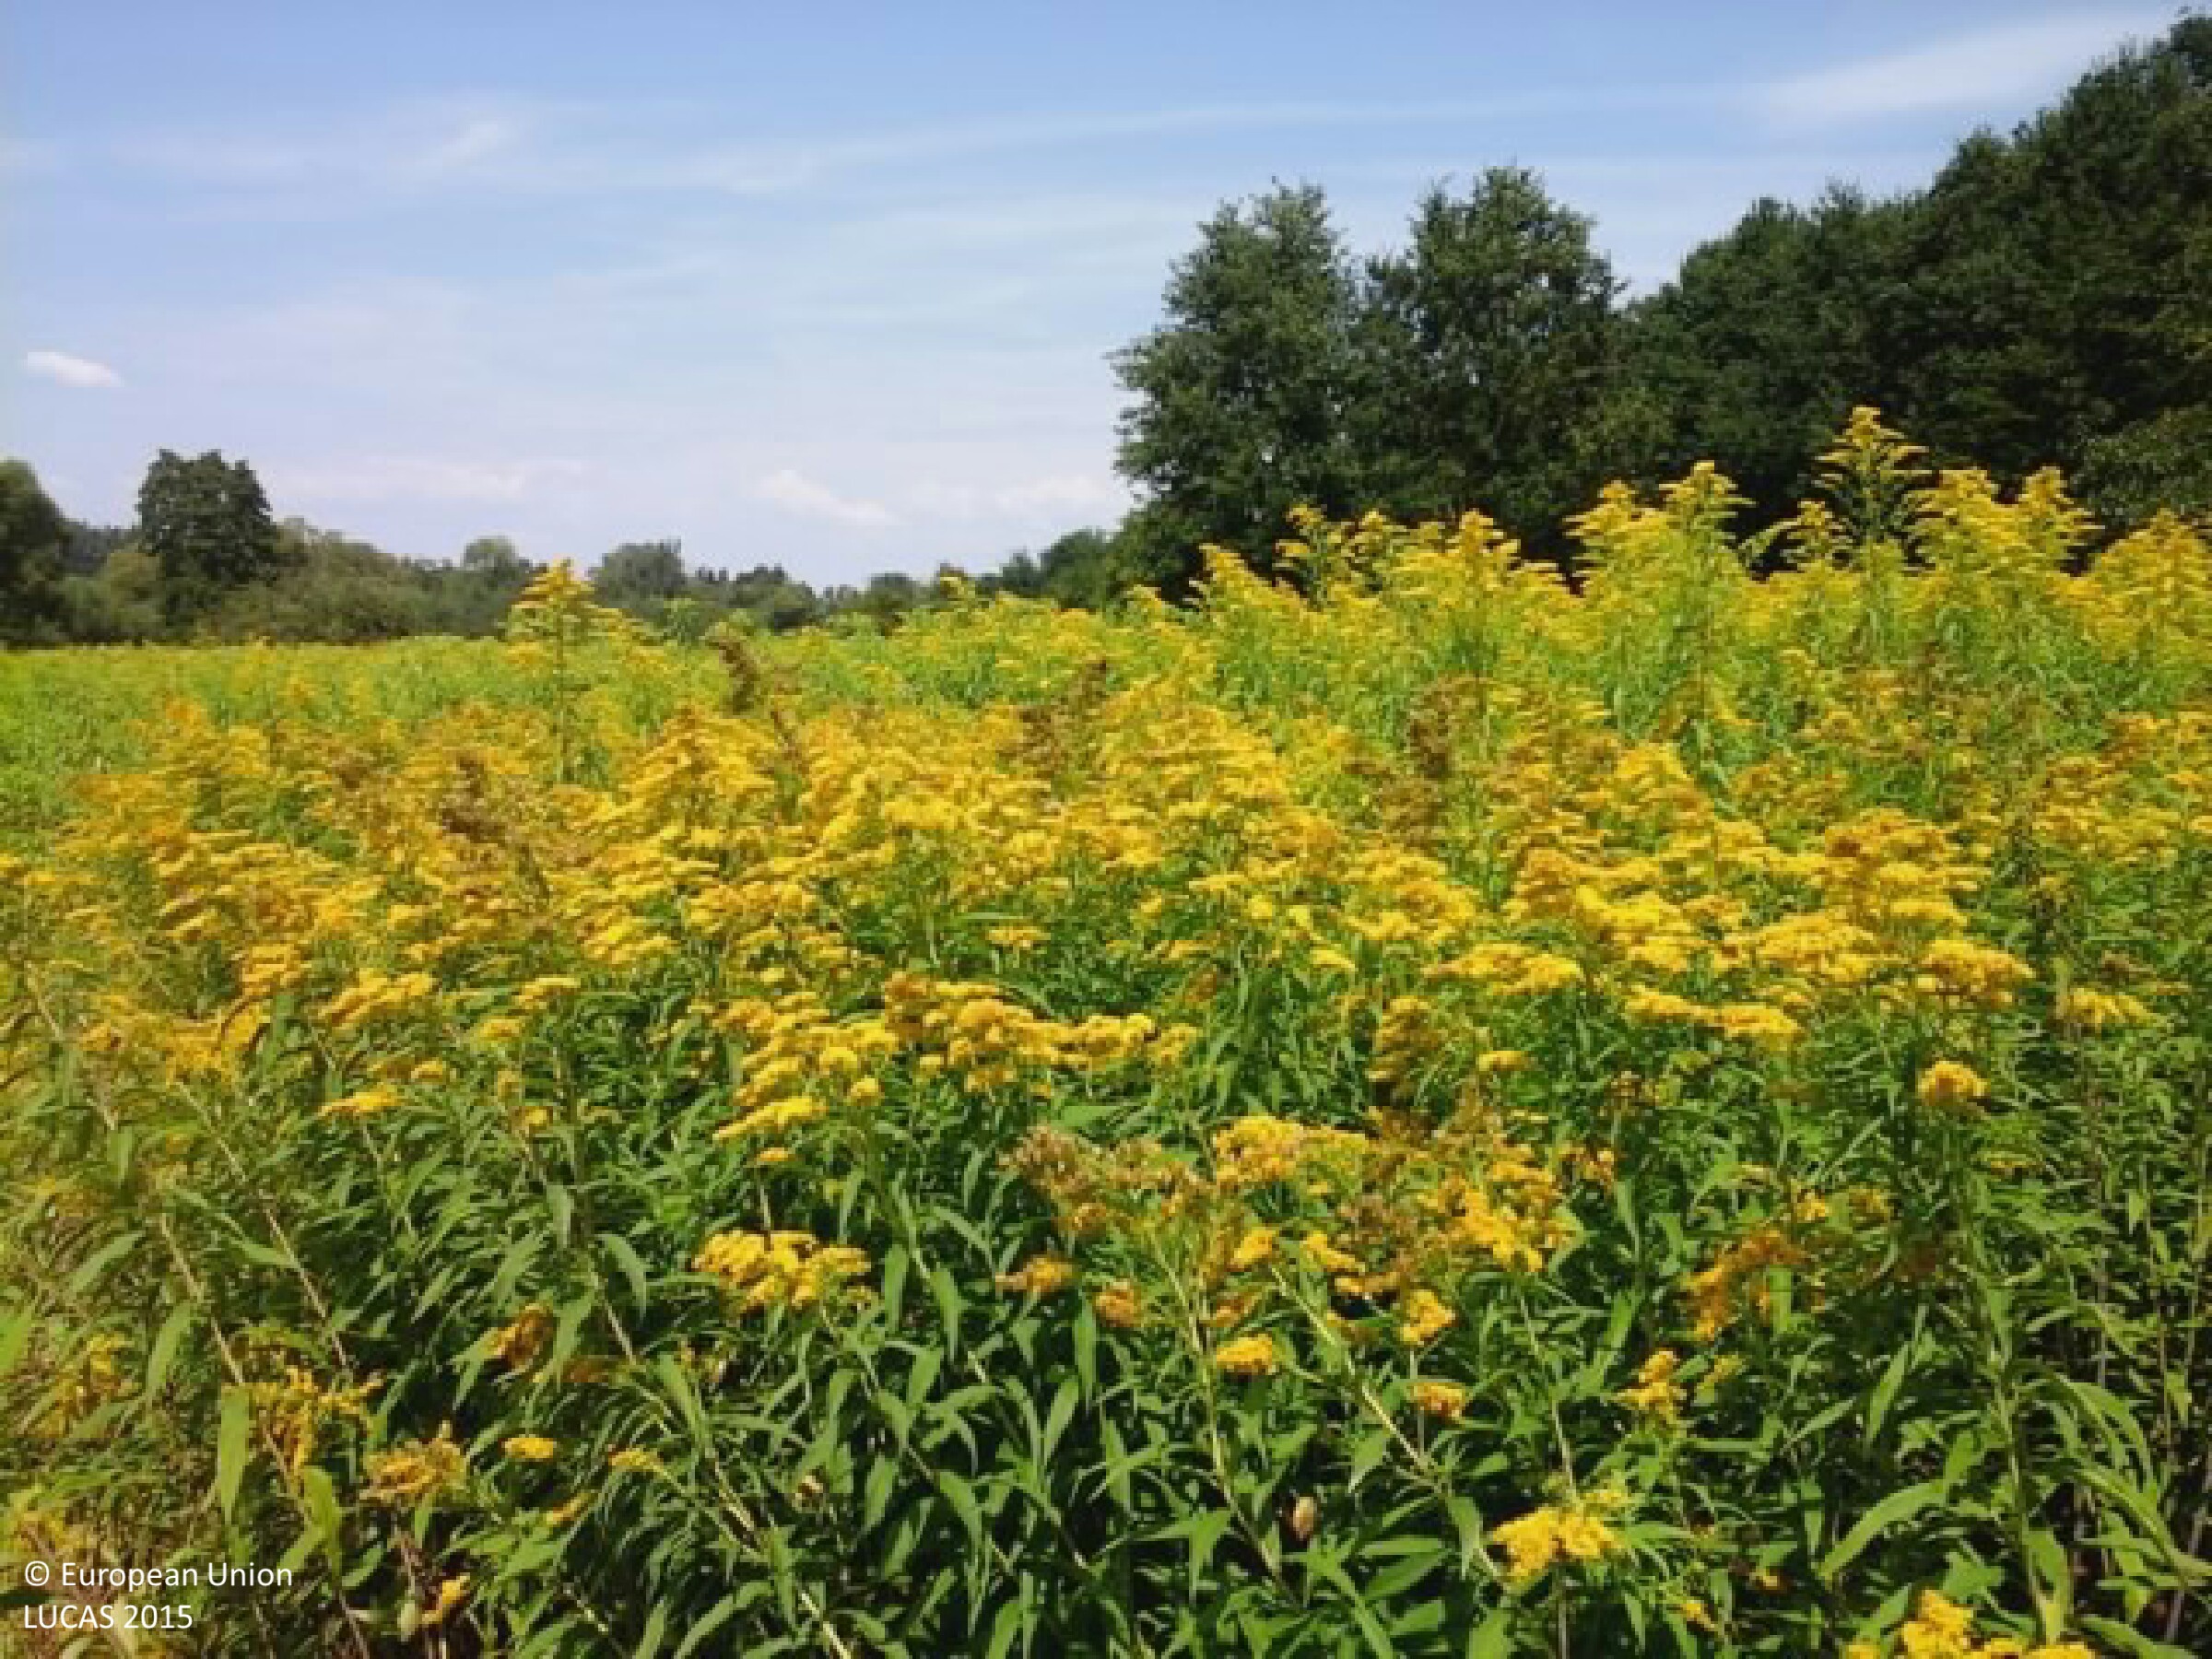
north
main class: Grassland
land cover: Spontaneously vegetated surfaces
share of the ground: > 75 %
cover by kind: herbaceous plants 95 %, shrubs 5 %
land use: Semi-natural and natural areas not in use
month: August
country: HU
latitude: 46.4066
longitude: 17.0662
